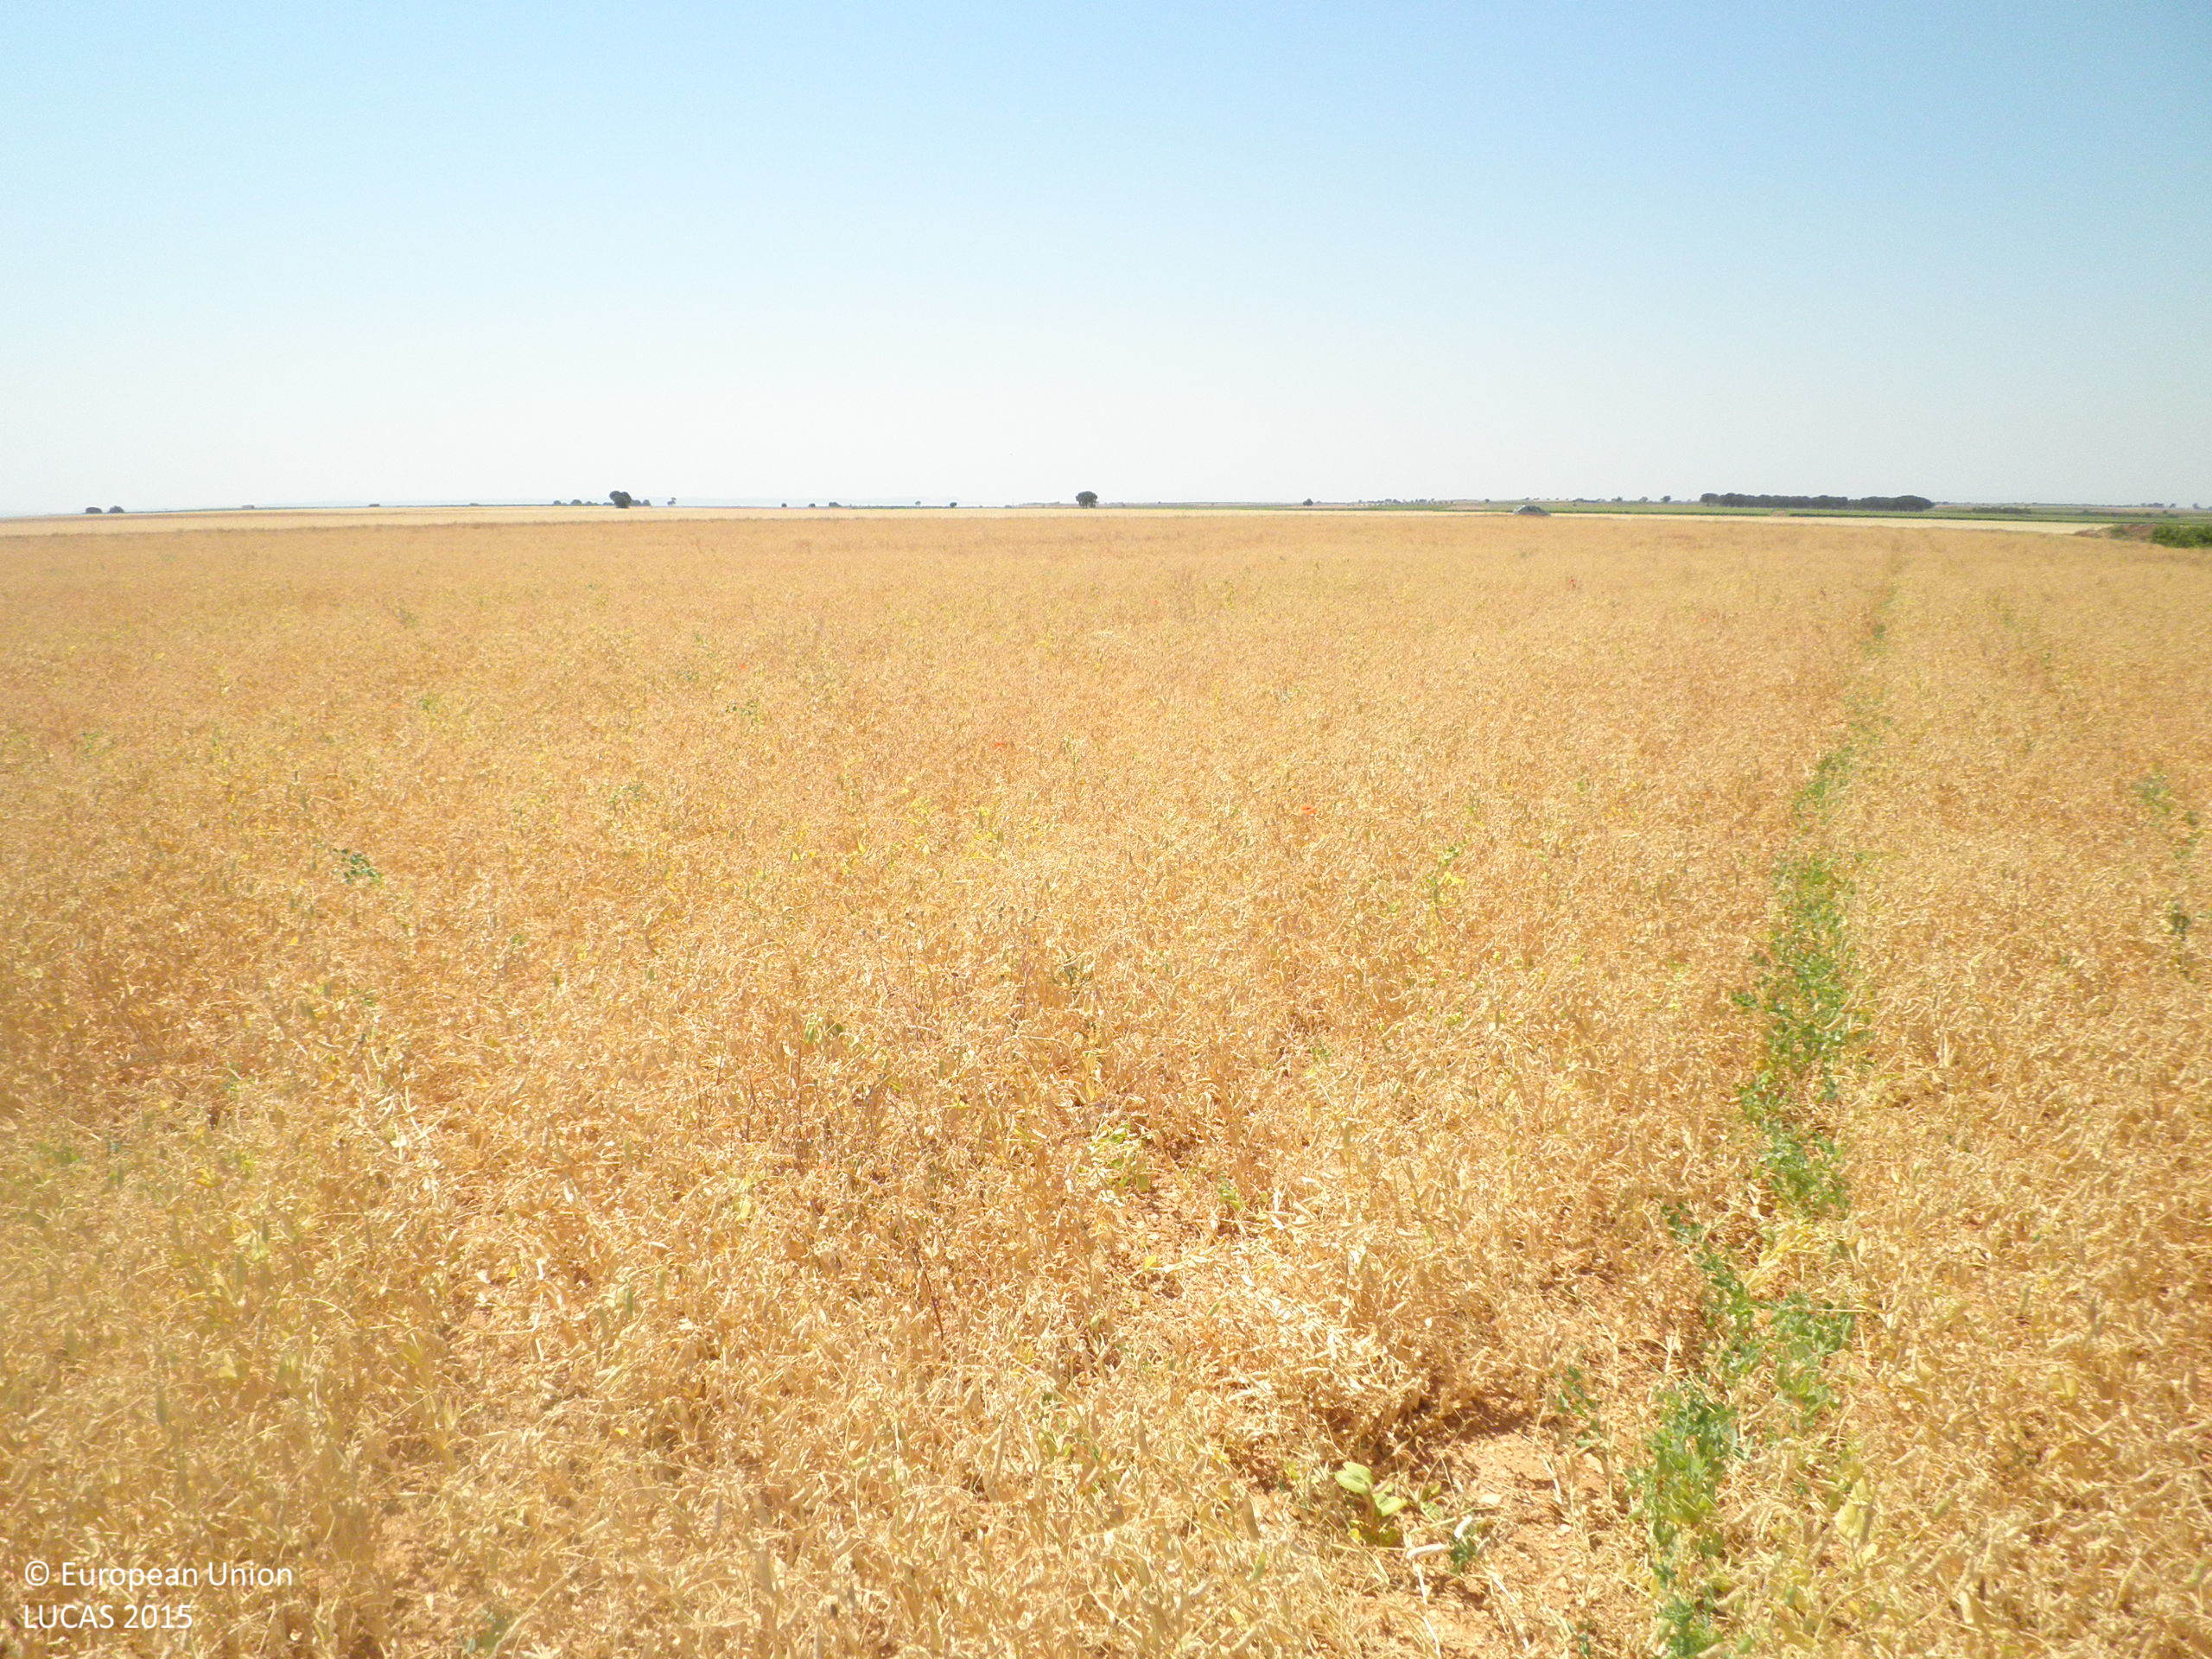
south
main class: Cropland
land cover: Dry pulses
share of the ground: > 75 %
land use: Agriculture (excluding fallow land and kitchen gardens)
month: June
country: ES
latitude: 39.2944
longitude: -1.8190
